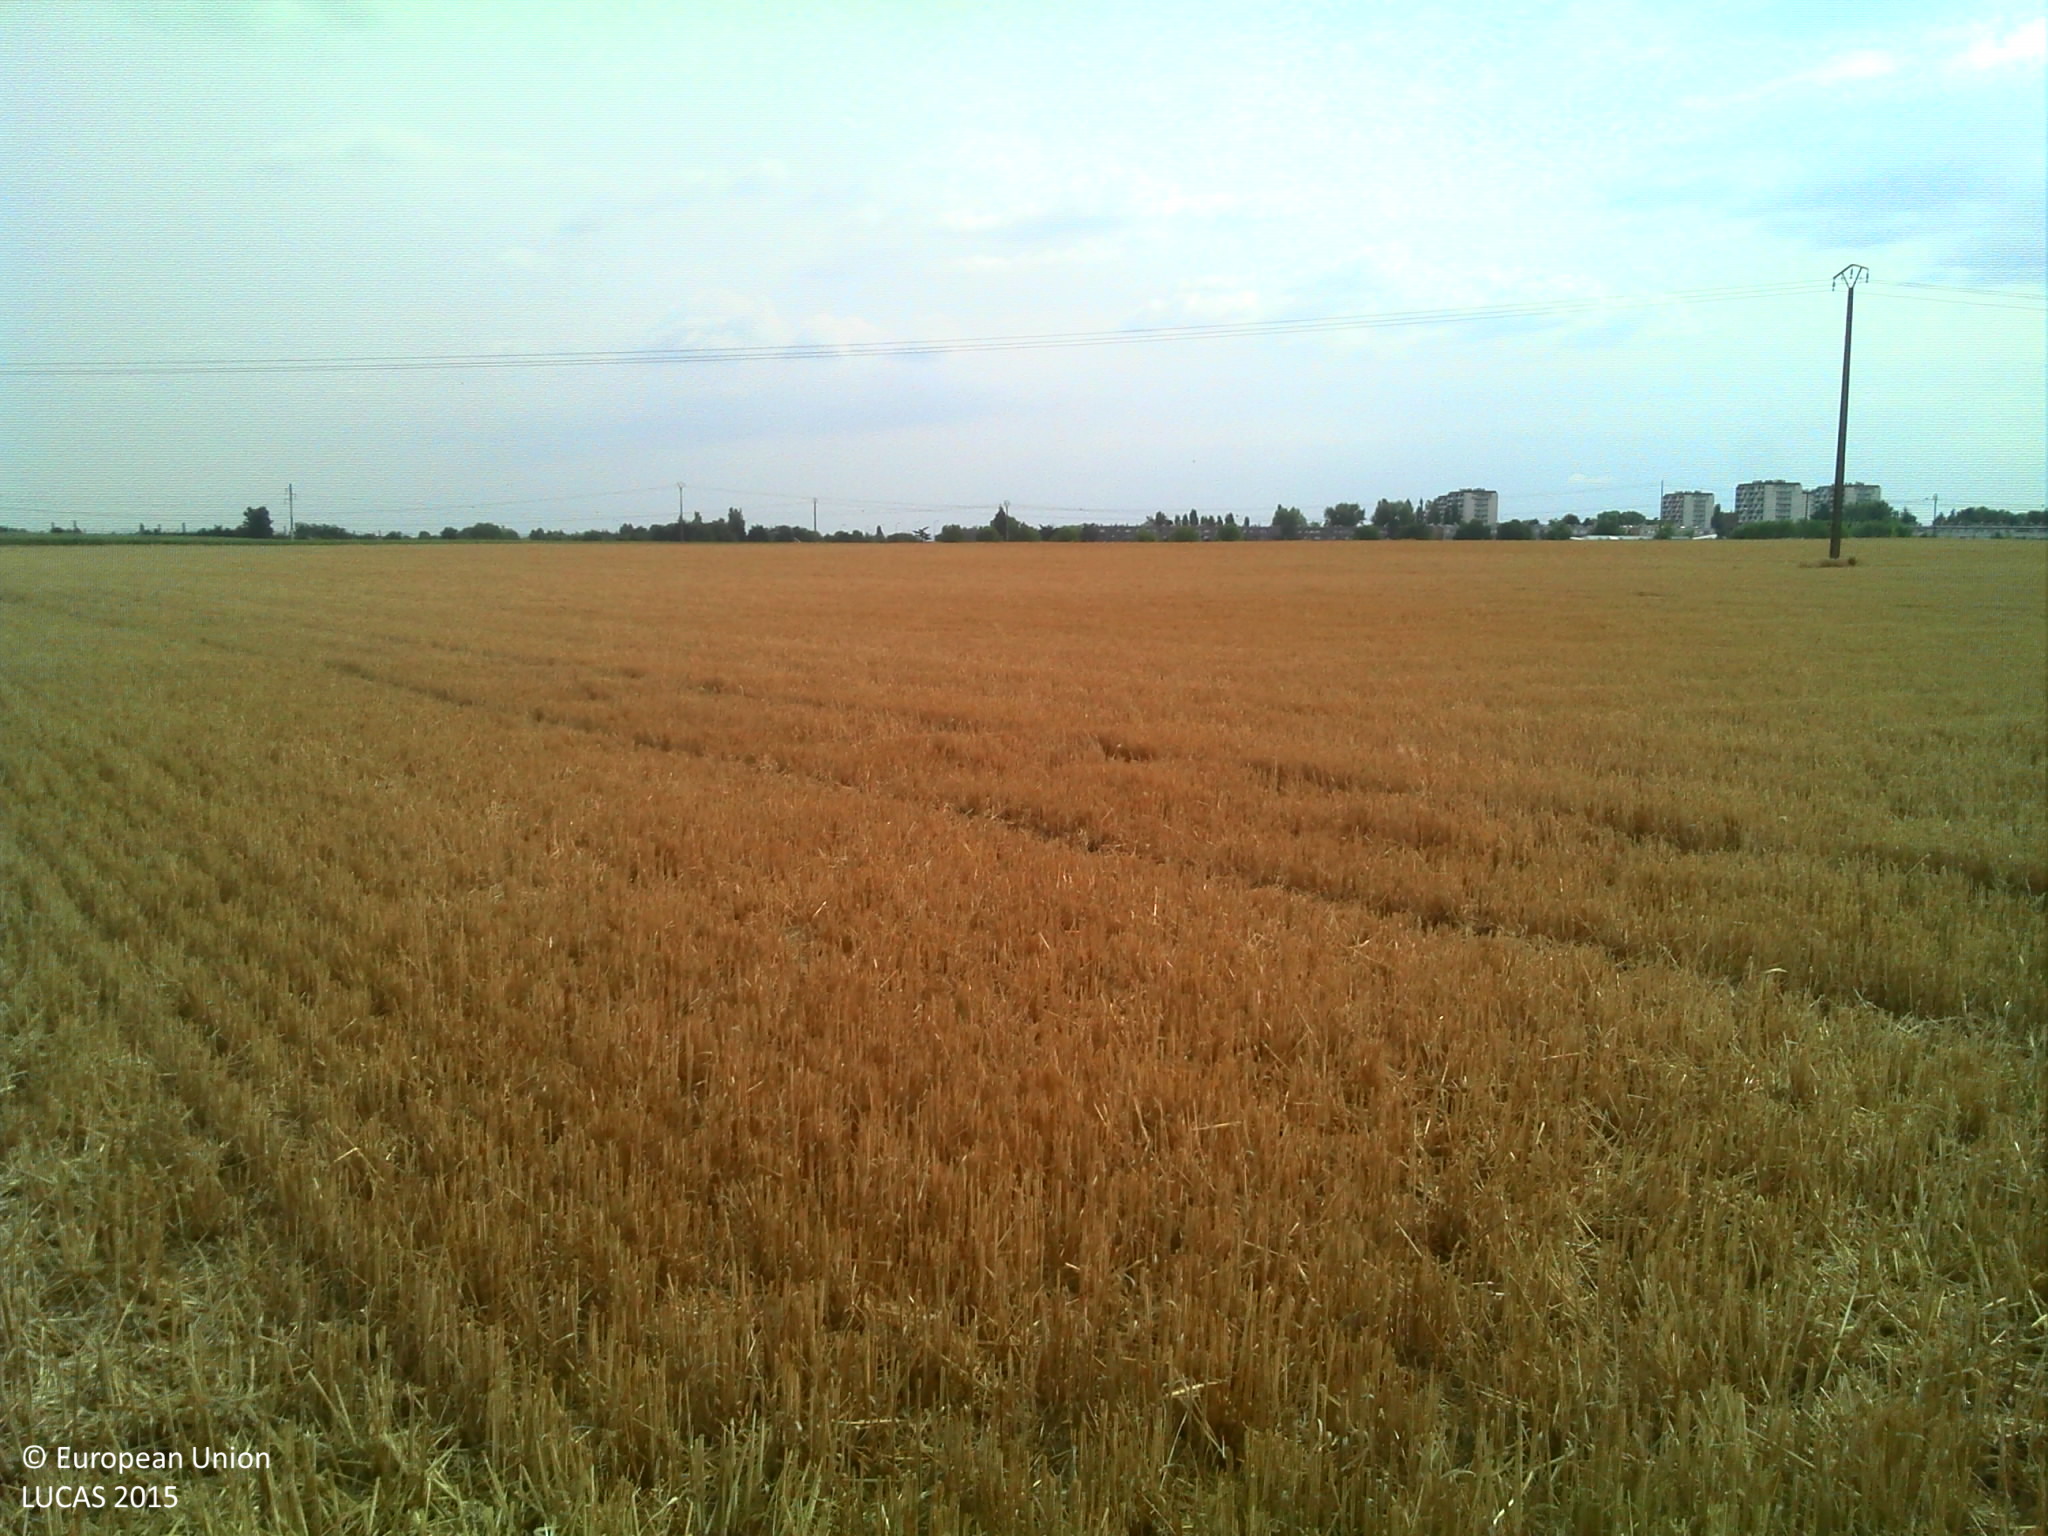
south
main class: Cropland
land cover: Common wheat
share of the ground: > 75 %
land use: Agriculture (excluding fallow land and kitchen gardens)
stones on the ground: < 10 %
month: August
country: FR
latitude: 49.0110
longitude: 2.4276
